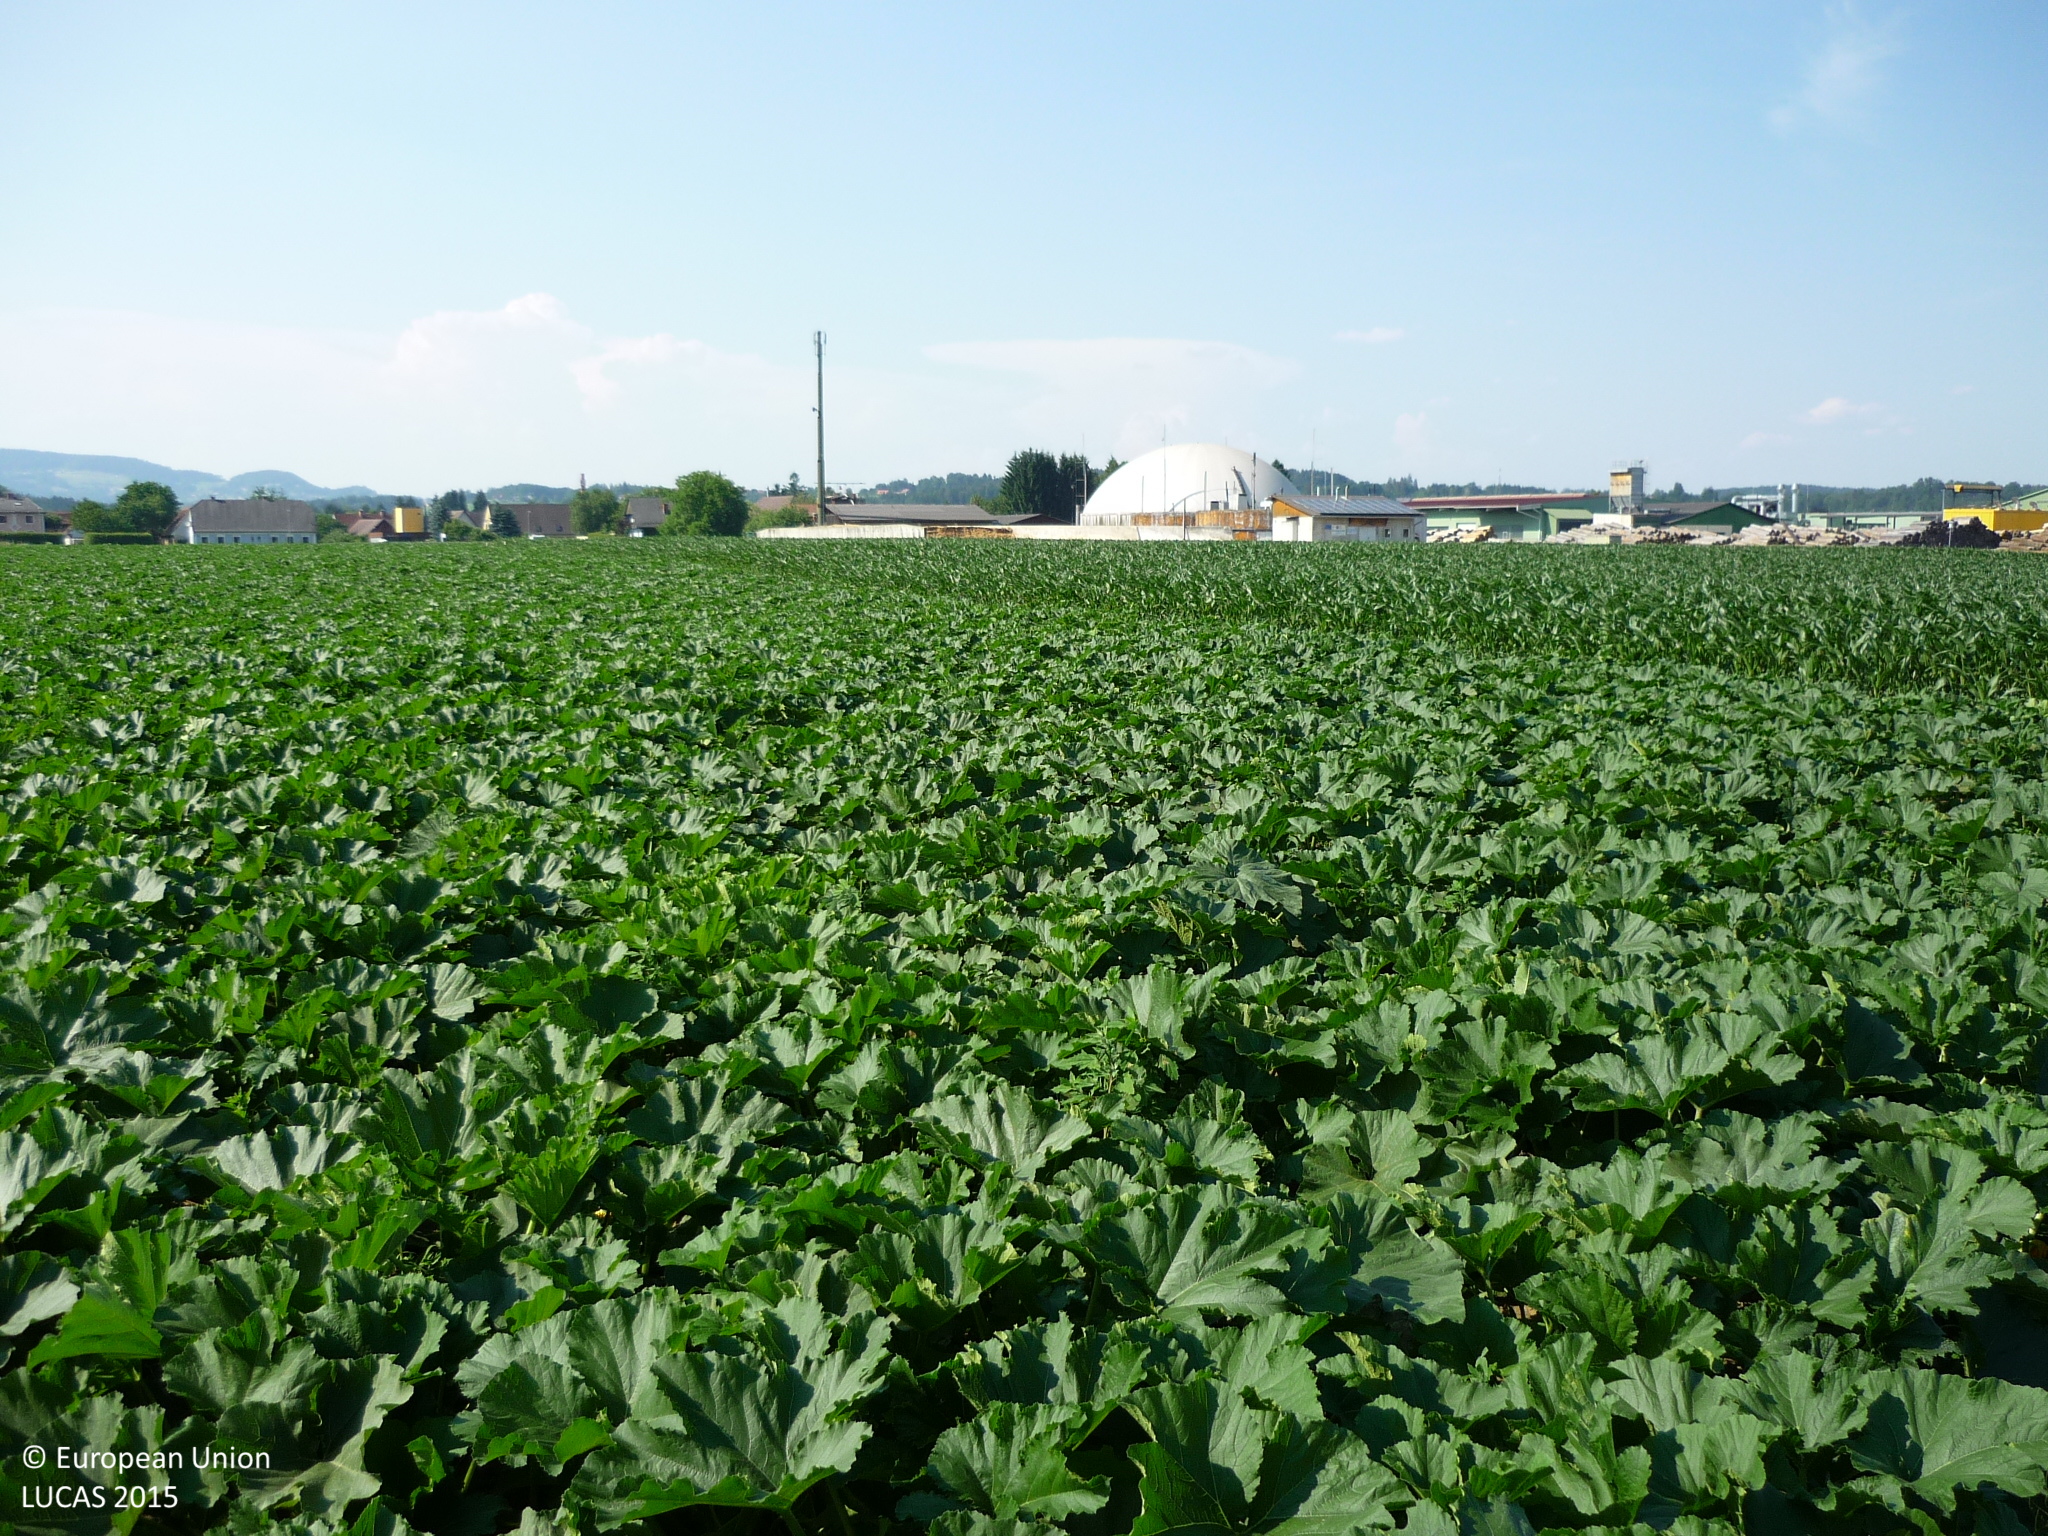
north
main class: Cropland
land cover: Other fresh vegetables
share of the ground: > 75 %
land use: Agriculture (excluding fallow land and kitchen gardens)
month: June
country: AT
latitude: 46.8176
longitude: 15.2547
